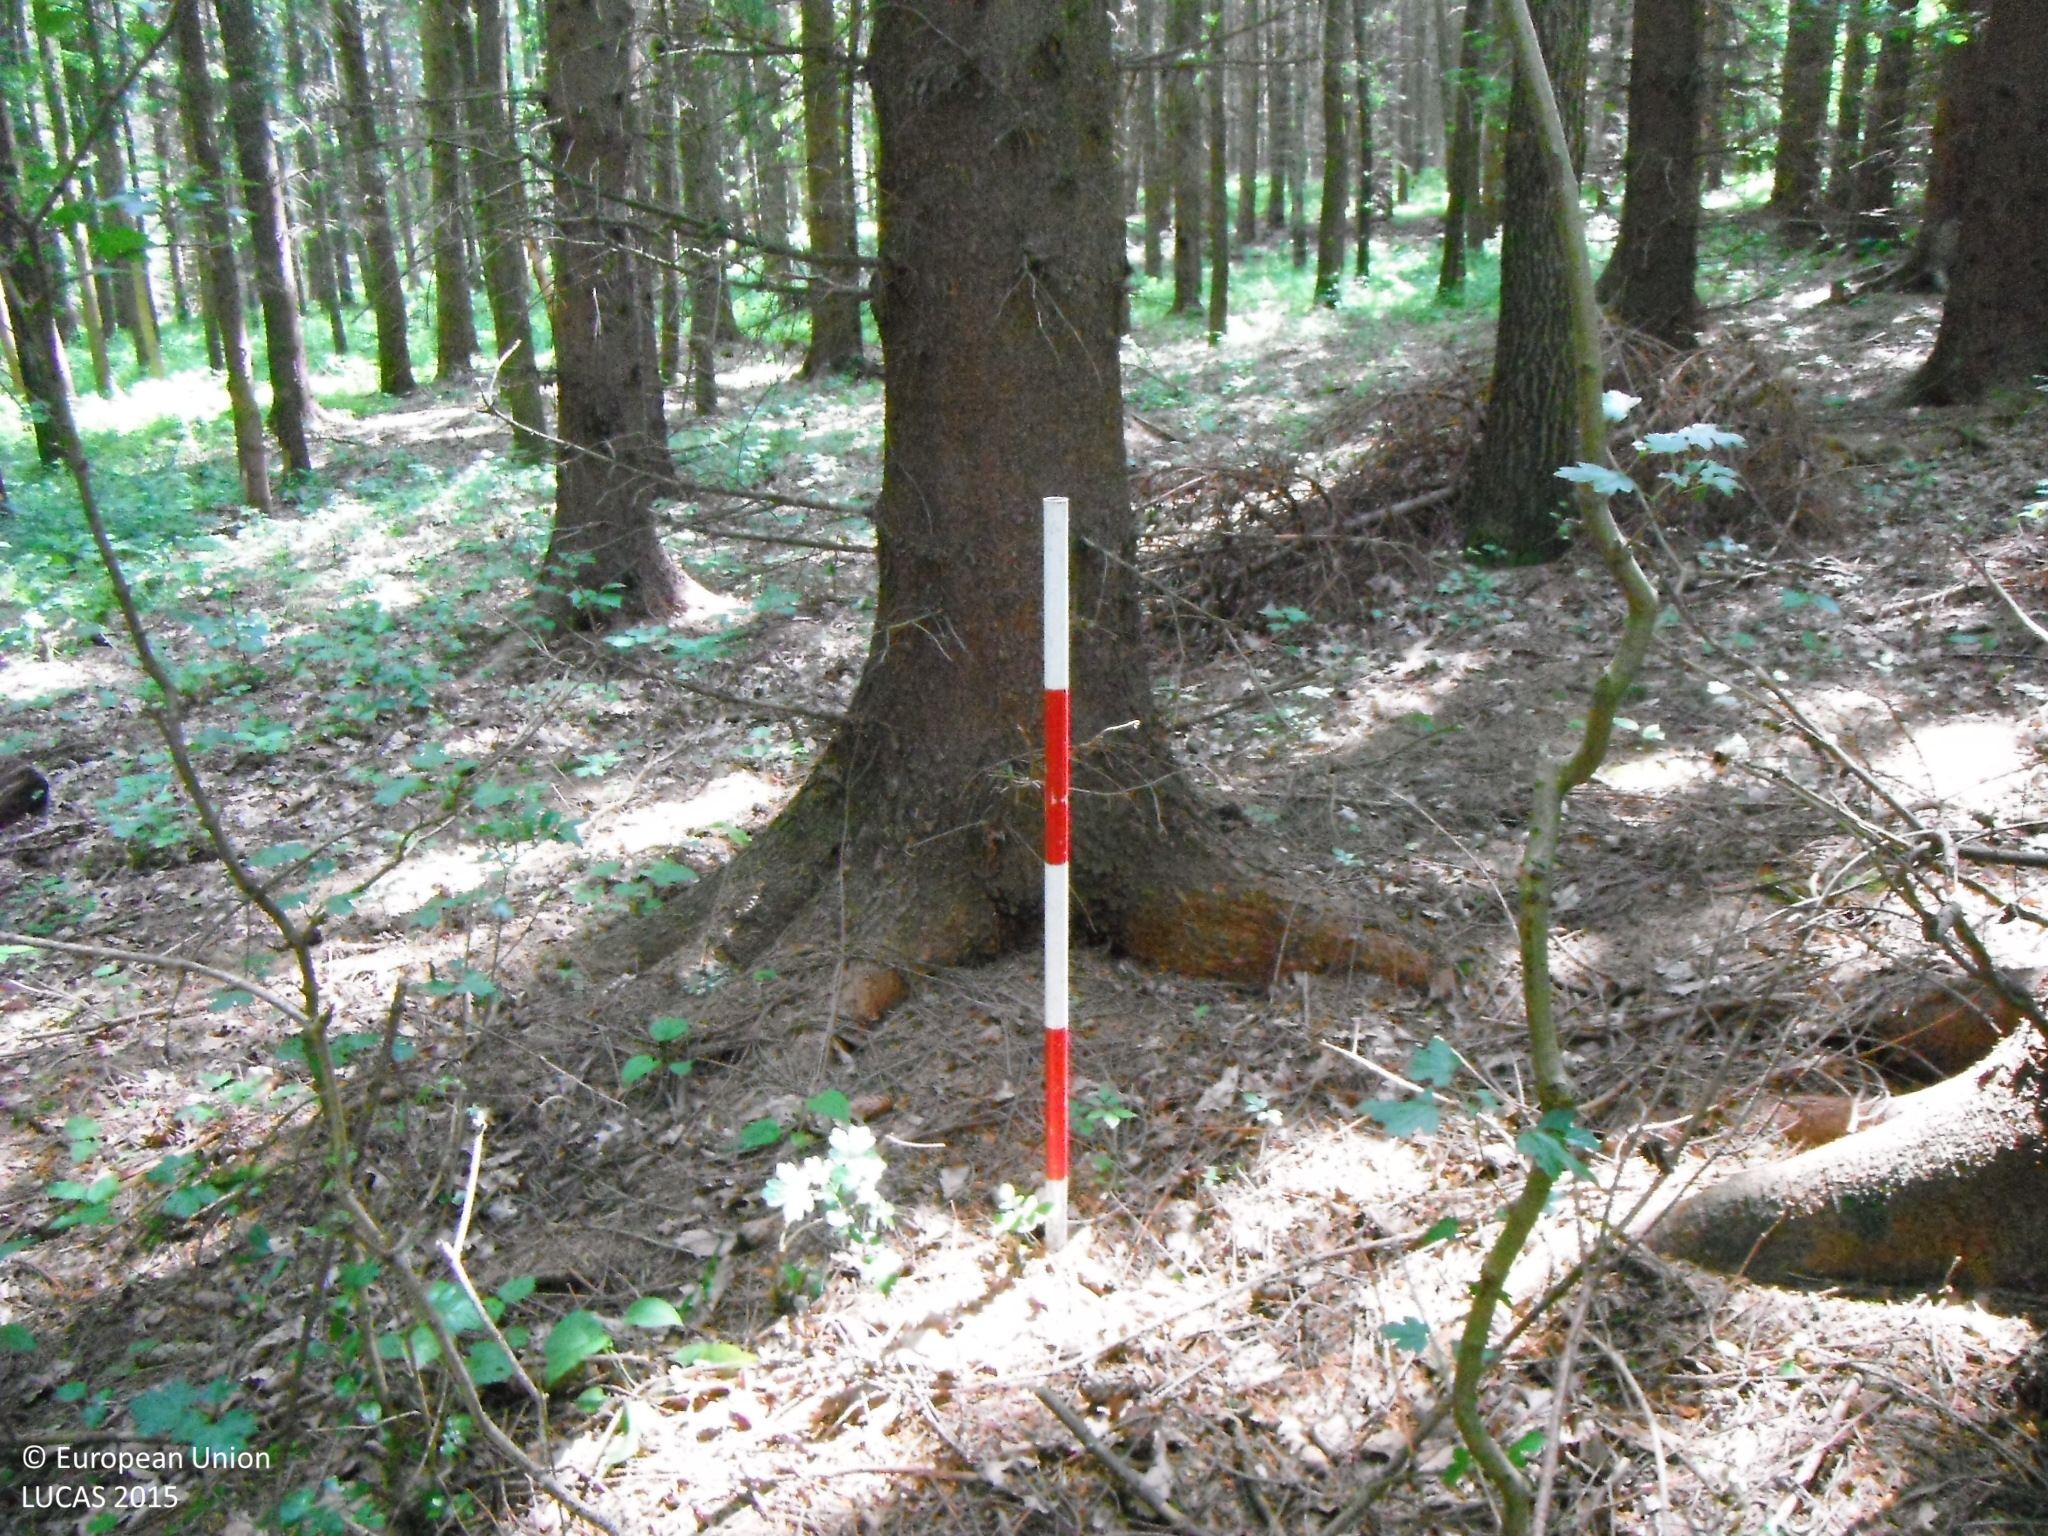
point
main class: Woodland
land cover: Spruce dominated coniferous woodland
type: hemiboreal forest and nemoral coniferous forest and mixed broadleaved-coniferous forest
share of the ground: > 75 %
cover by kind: coniferous forest trees 100 %
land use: Forestry
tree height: > 5 m
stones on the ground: < 10 %
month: June
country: SK
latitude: 48.7070
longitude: 18.7570
